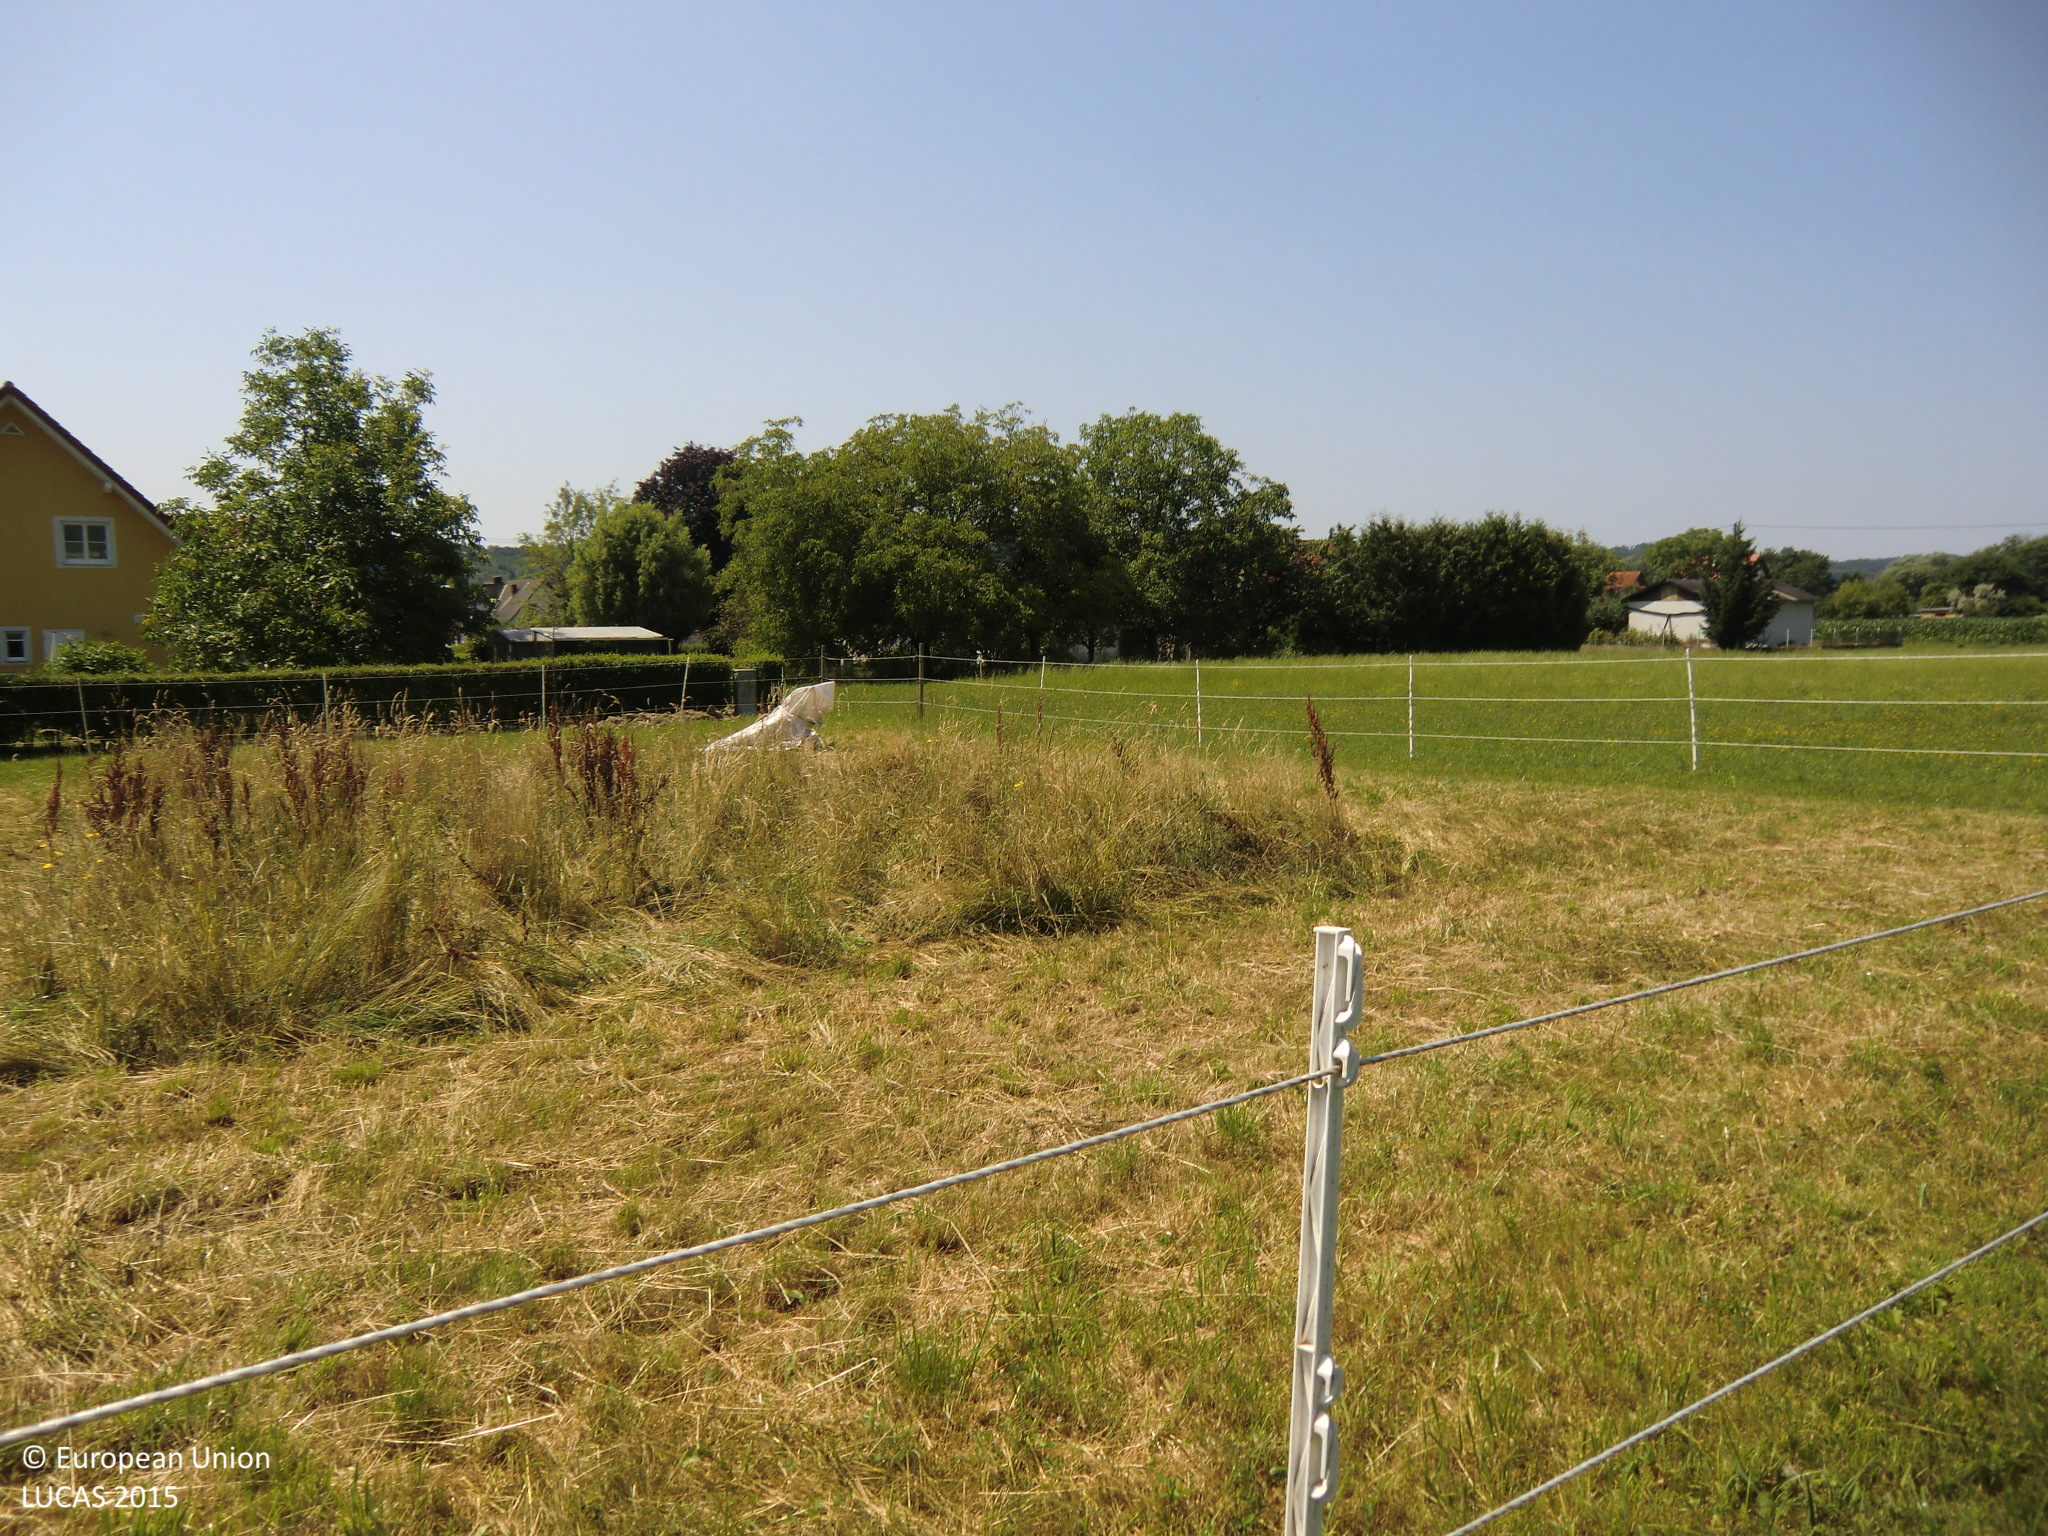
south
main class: Grassland
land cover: Grassland with sparse tree/shrub cover
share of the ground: > 75 %
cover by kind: herbaceous plants 95 %, coniferous forest trees 5 %
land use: Residential
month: July
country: AT
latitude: 47.0887
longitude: 15.9421
